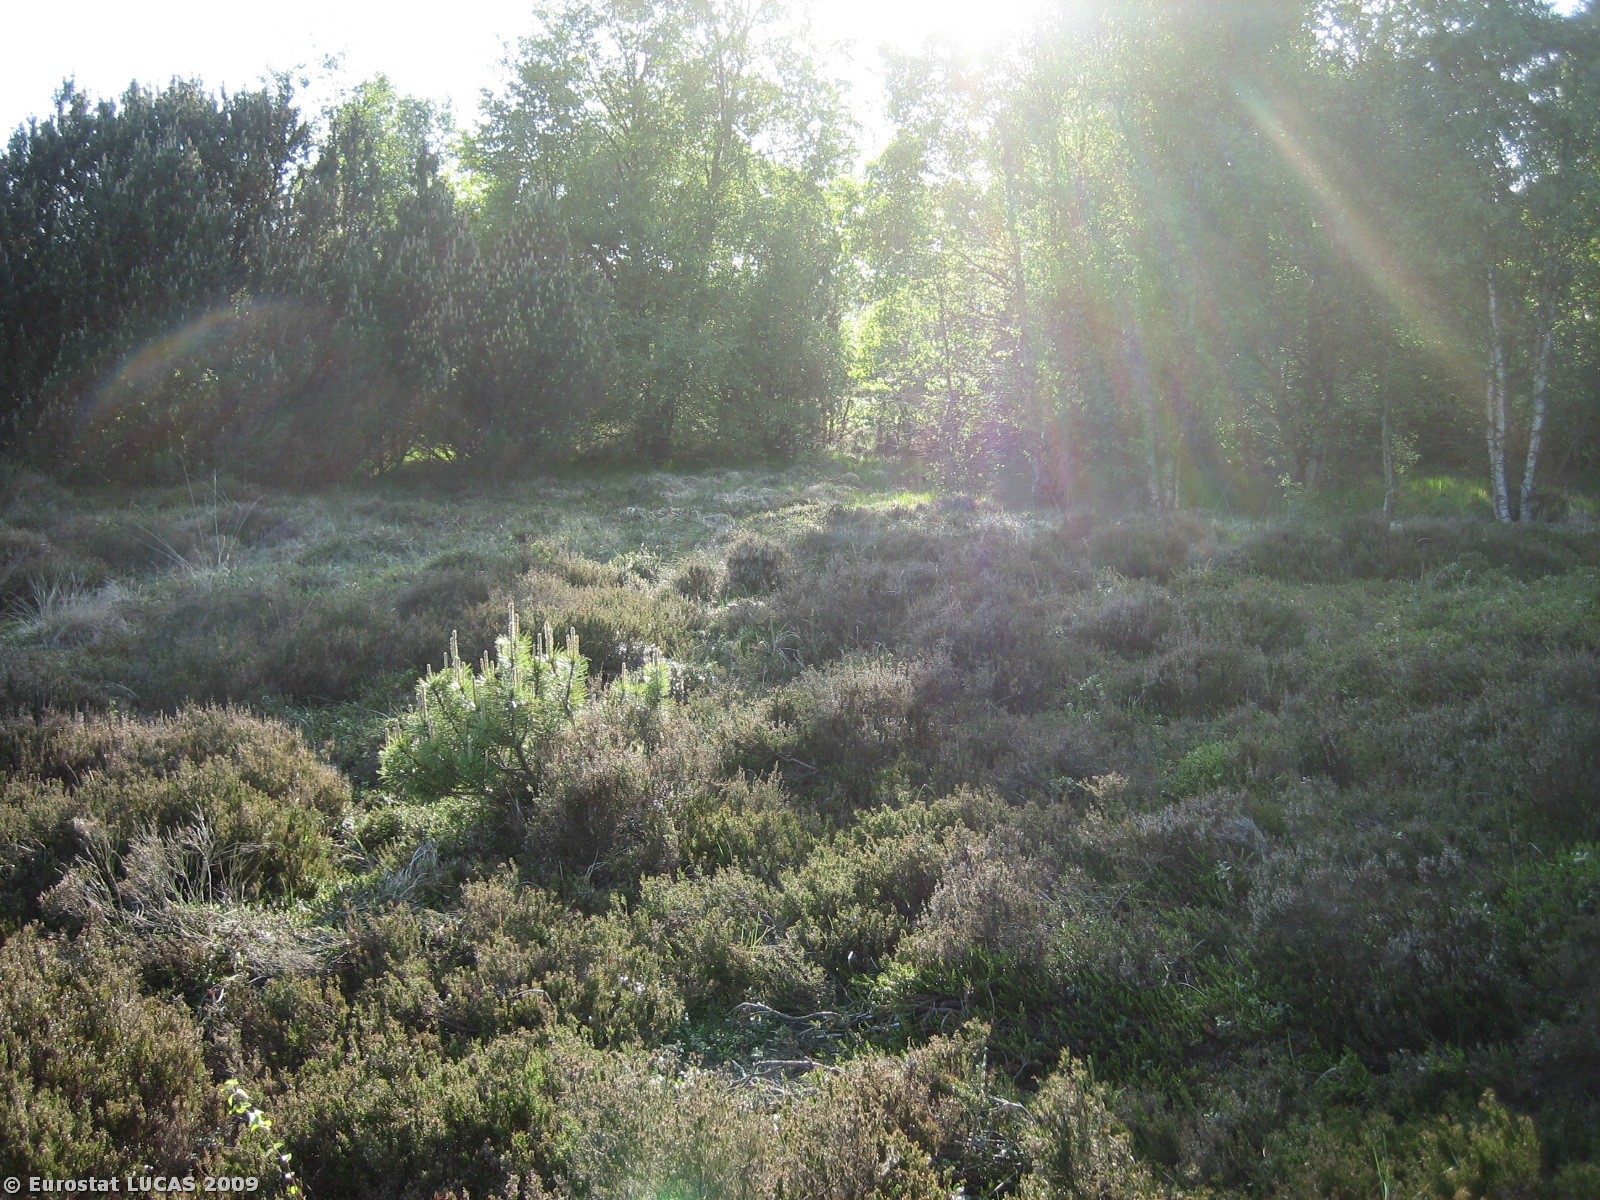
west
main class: Shrubland
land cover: Shrubland with sparse tree cover
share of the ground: > 75 %
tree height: > 5 m
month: May
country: DK
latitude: 55.9696
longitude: 9.2158
